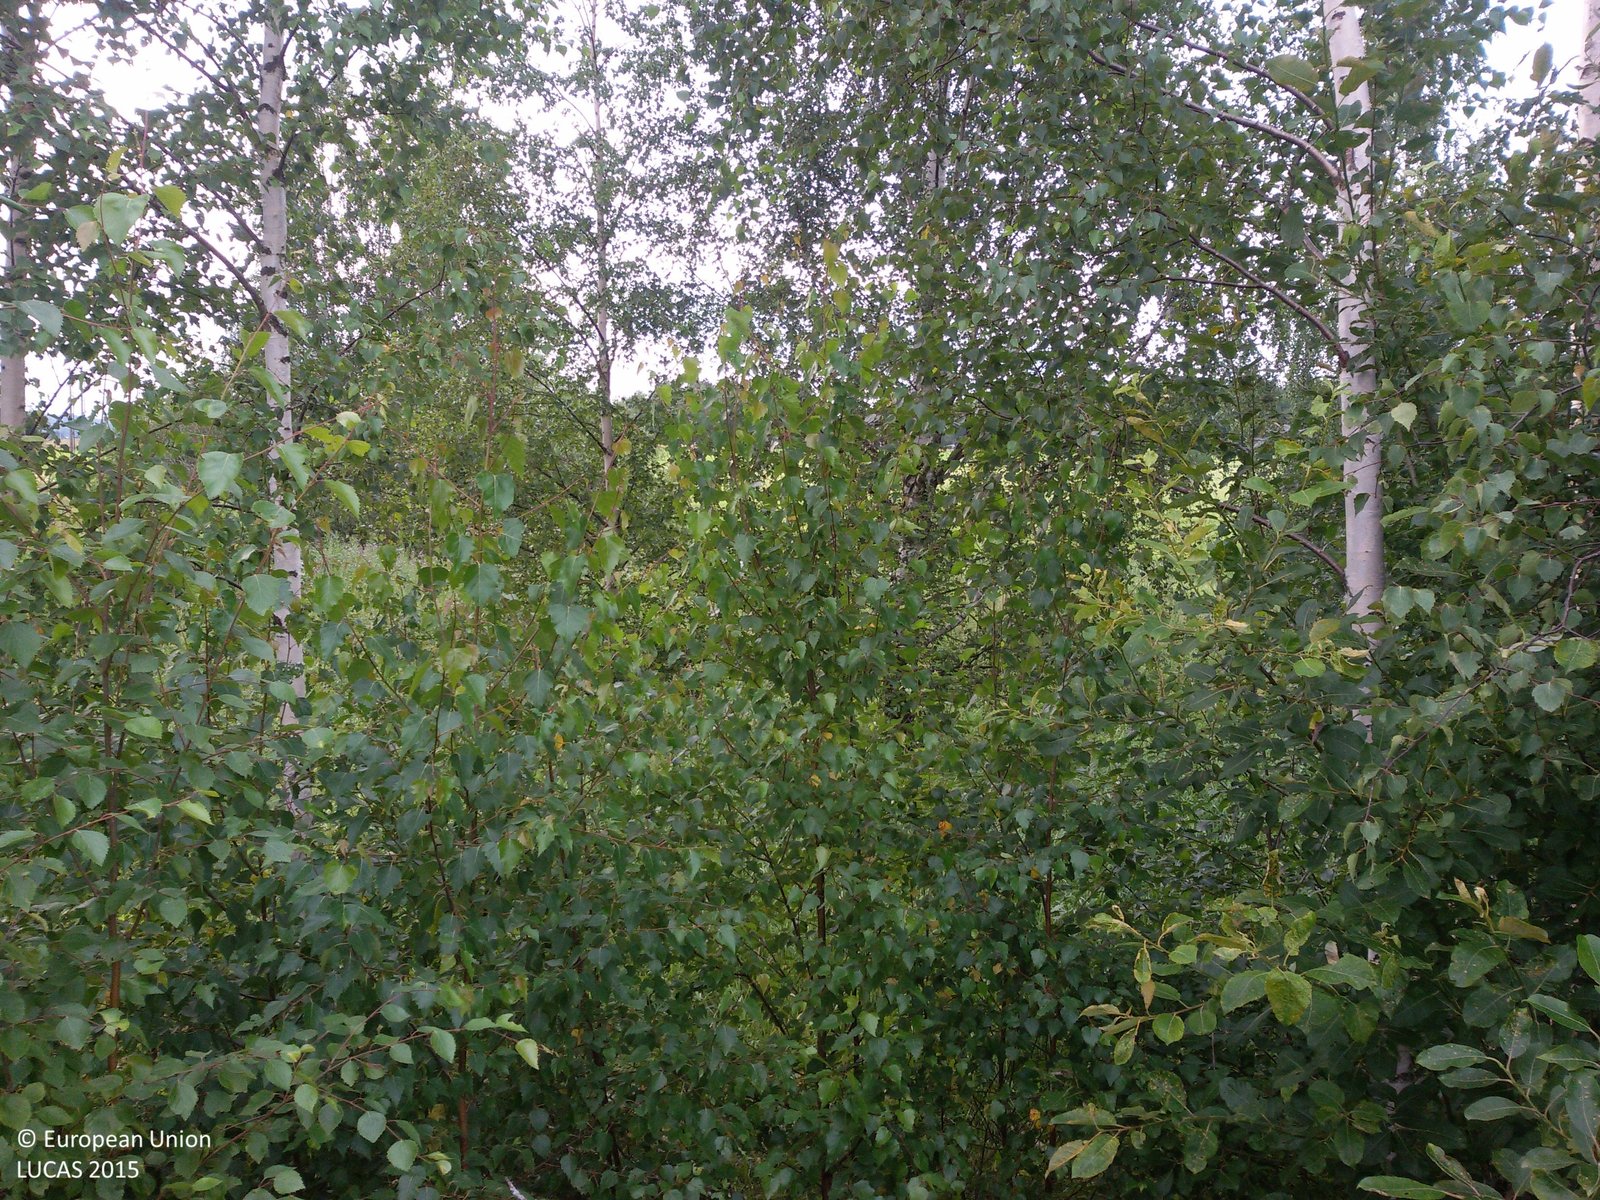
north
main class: Grassland
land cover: Spontaneously vegetated surfaces
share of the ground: > 75 %
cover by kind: herbaceous plants 100 %
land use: Semi-natural and natural areas not in use
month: July
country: SE
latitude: 60.4039
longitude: 15.8149
